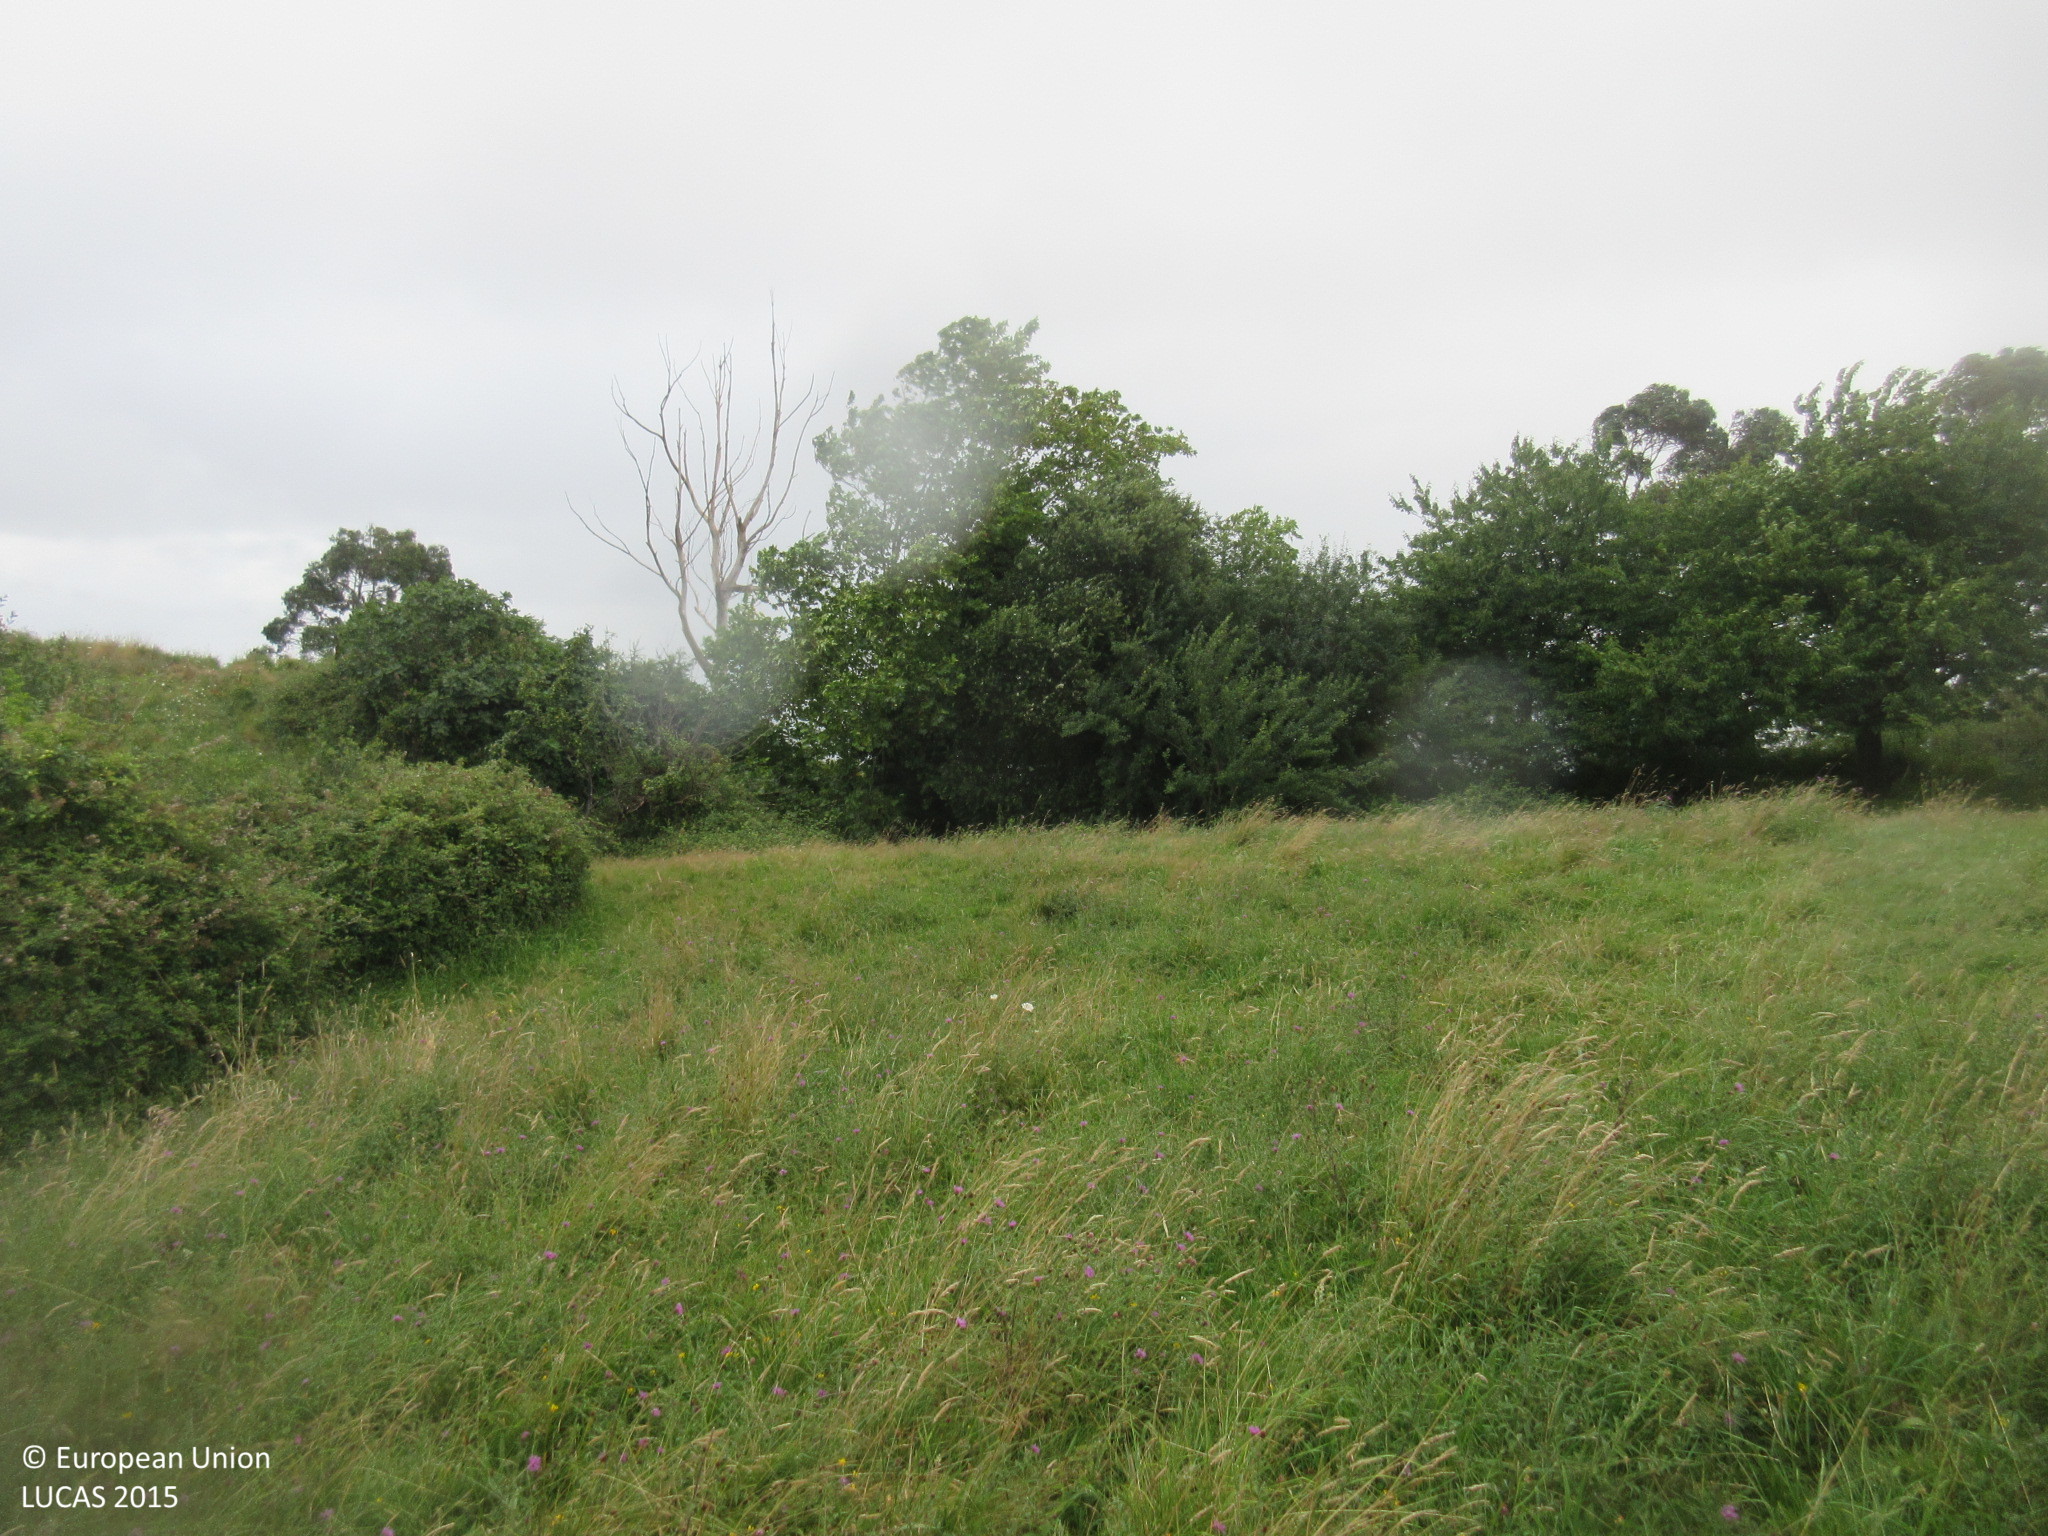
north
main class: Grassland
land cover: Grassland without tree/shrub cover
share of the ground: > 75 %
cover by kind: herbaceous plants 100 %
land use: Agriculture (excluding fallow land and kitchen gardens)
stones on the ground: < 10 %
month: July
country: ES
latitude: 43.3540
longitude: -4.5581
